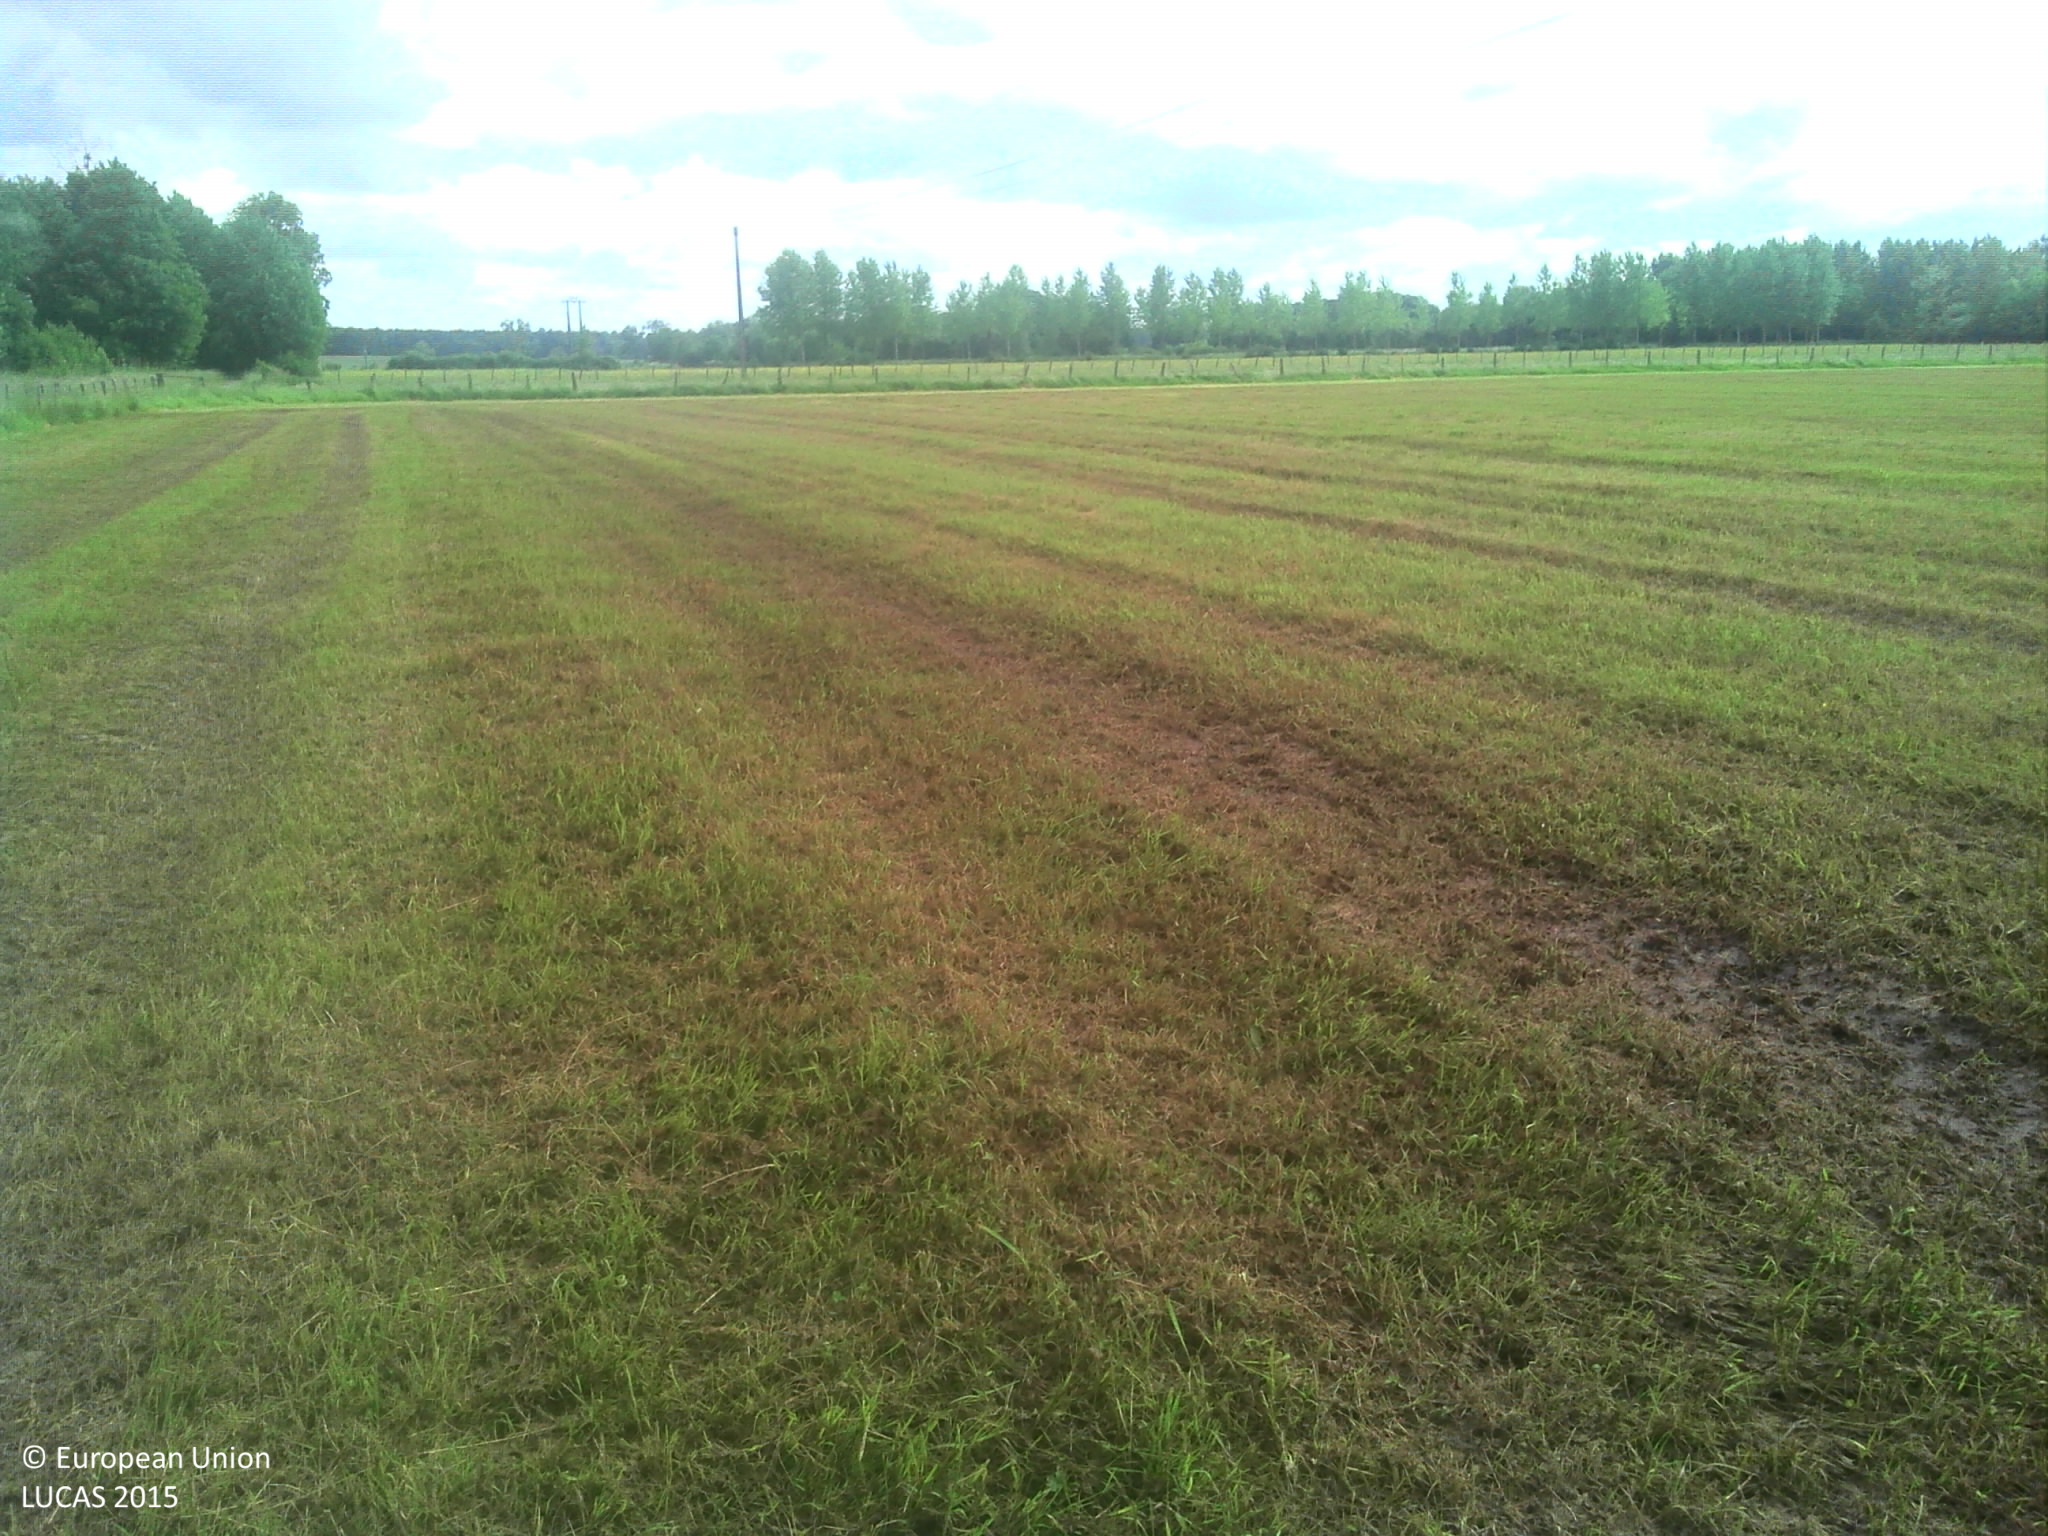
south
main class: Grassland
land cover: Grassland without tree/shrub cover
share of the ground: > 75 %
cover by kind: herbaceous plants 100 %
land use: Agriculture (excluding fallow land and kitchen gardens)
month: June
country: FR
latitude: 48.4931
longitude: 4.7068
